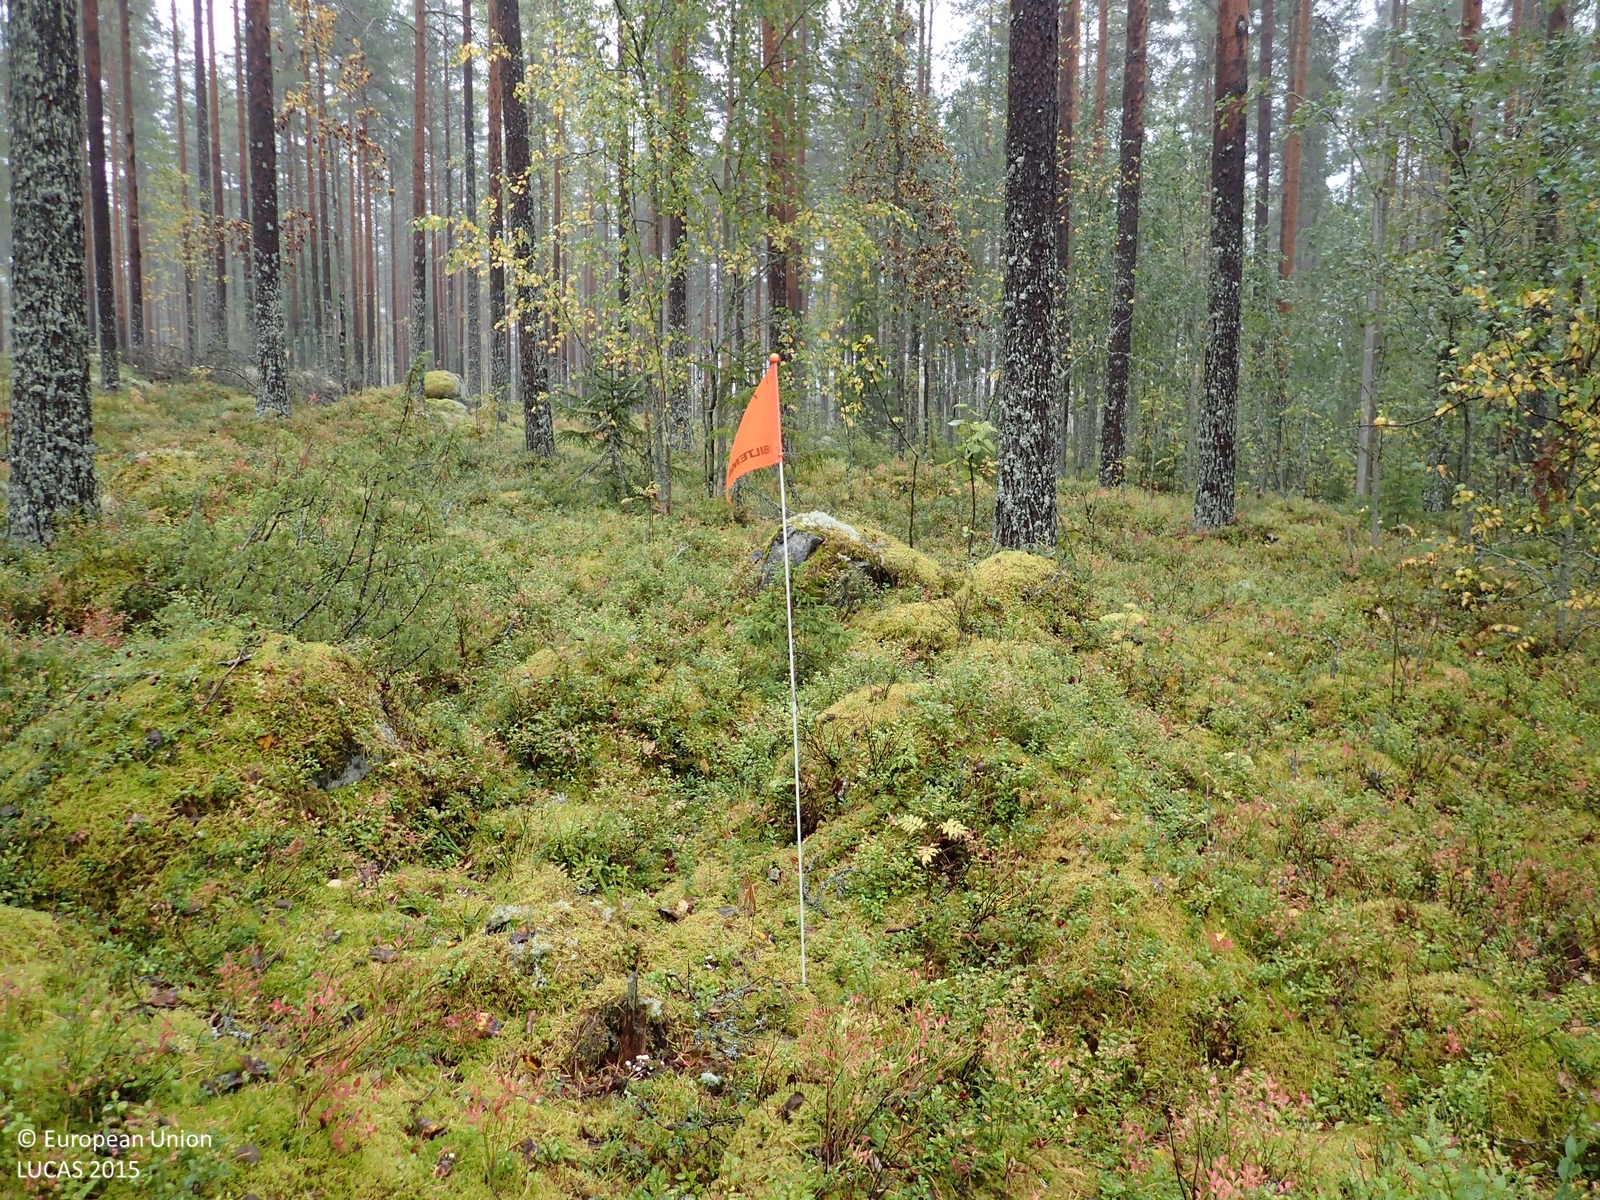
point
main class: Woodland
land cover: Pine dominated mixed woodland
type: boreal forest
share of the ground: 50 - 75 %
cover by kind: coniferous forest trees 55 %, broadleaved forest trees 20 %, shrubs 20 %, lichens and mosses 5 %
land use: Forestry
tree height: > 5 m
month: September
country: FI
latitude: 63.2270
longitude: 25.2817
